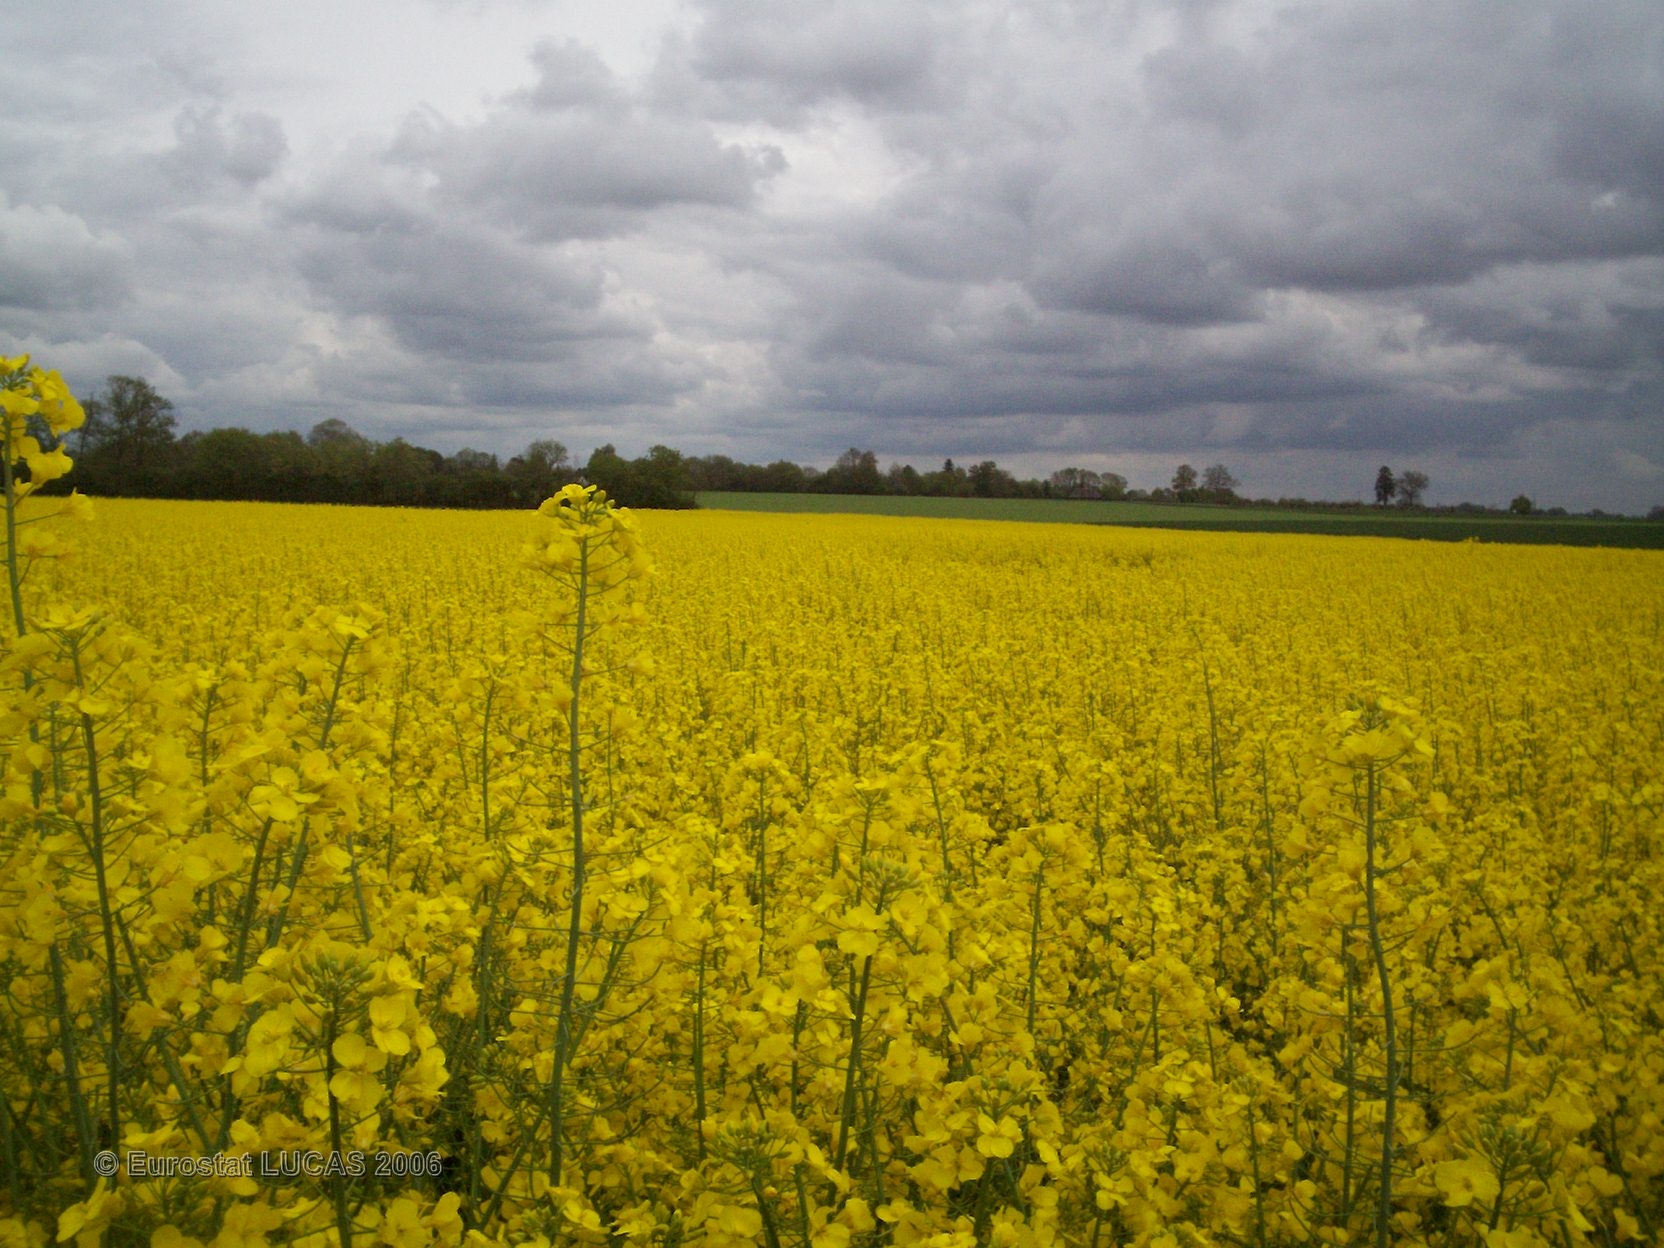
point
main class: Cropland
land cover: Rape and turnip rape
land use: Agriculture (excluding fallow land and kitchen gardens)
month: May
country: FR
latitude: 49.1529
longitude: 0.4995
